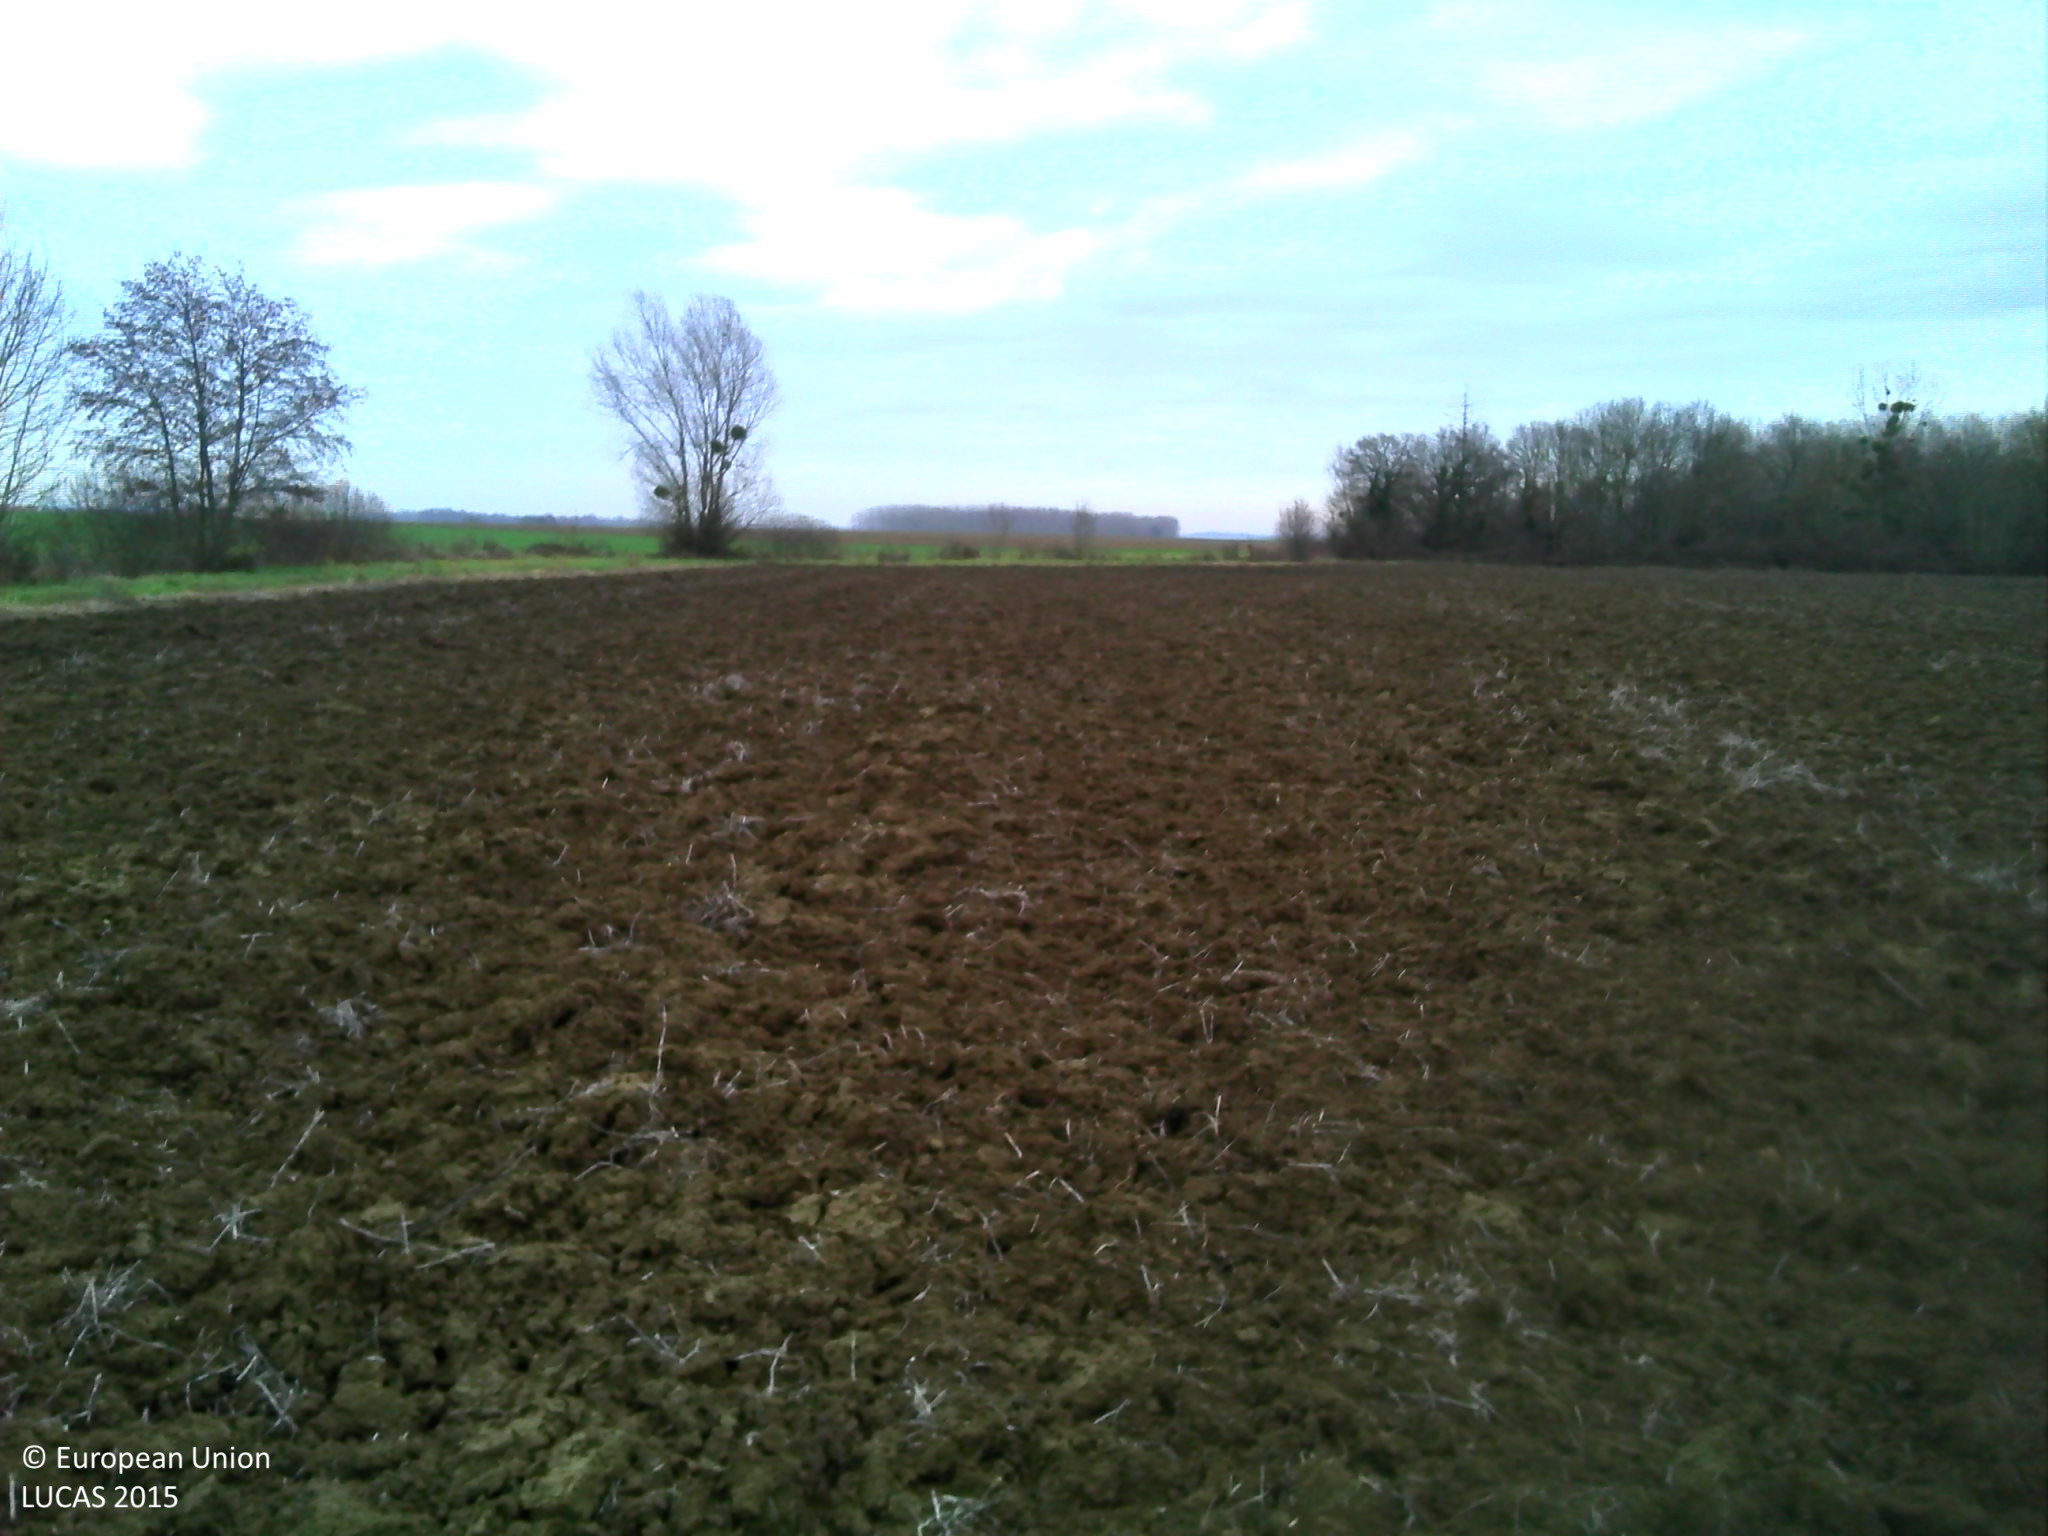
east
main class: Cropland
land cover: Dry pulses
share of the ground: < 10 %
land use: Agriculture (excluding fallow land and kitchen gardens)
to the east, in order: Dry pulses; Grassland without tree/shrub cover; Single bushes/trees; Rivers and streams; Grassland without tree/shrub cover; Common wheat
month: December
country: FR
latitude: 47.3471
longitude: 5.2752
